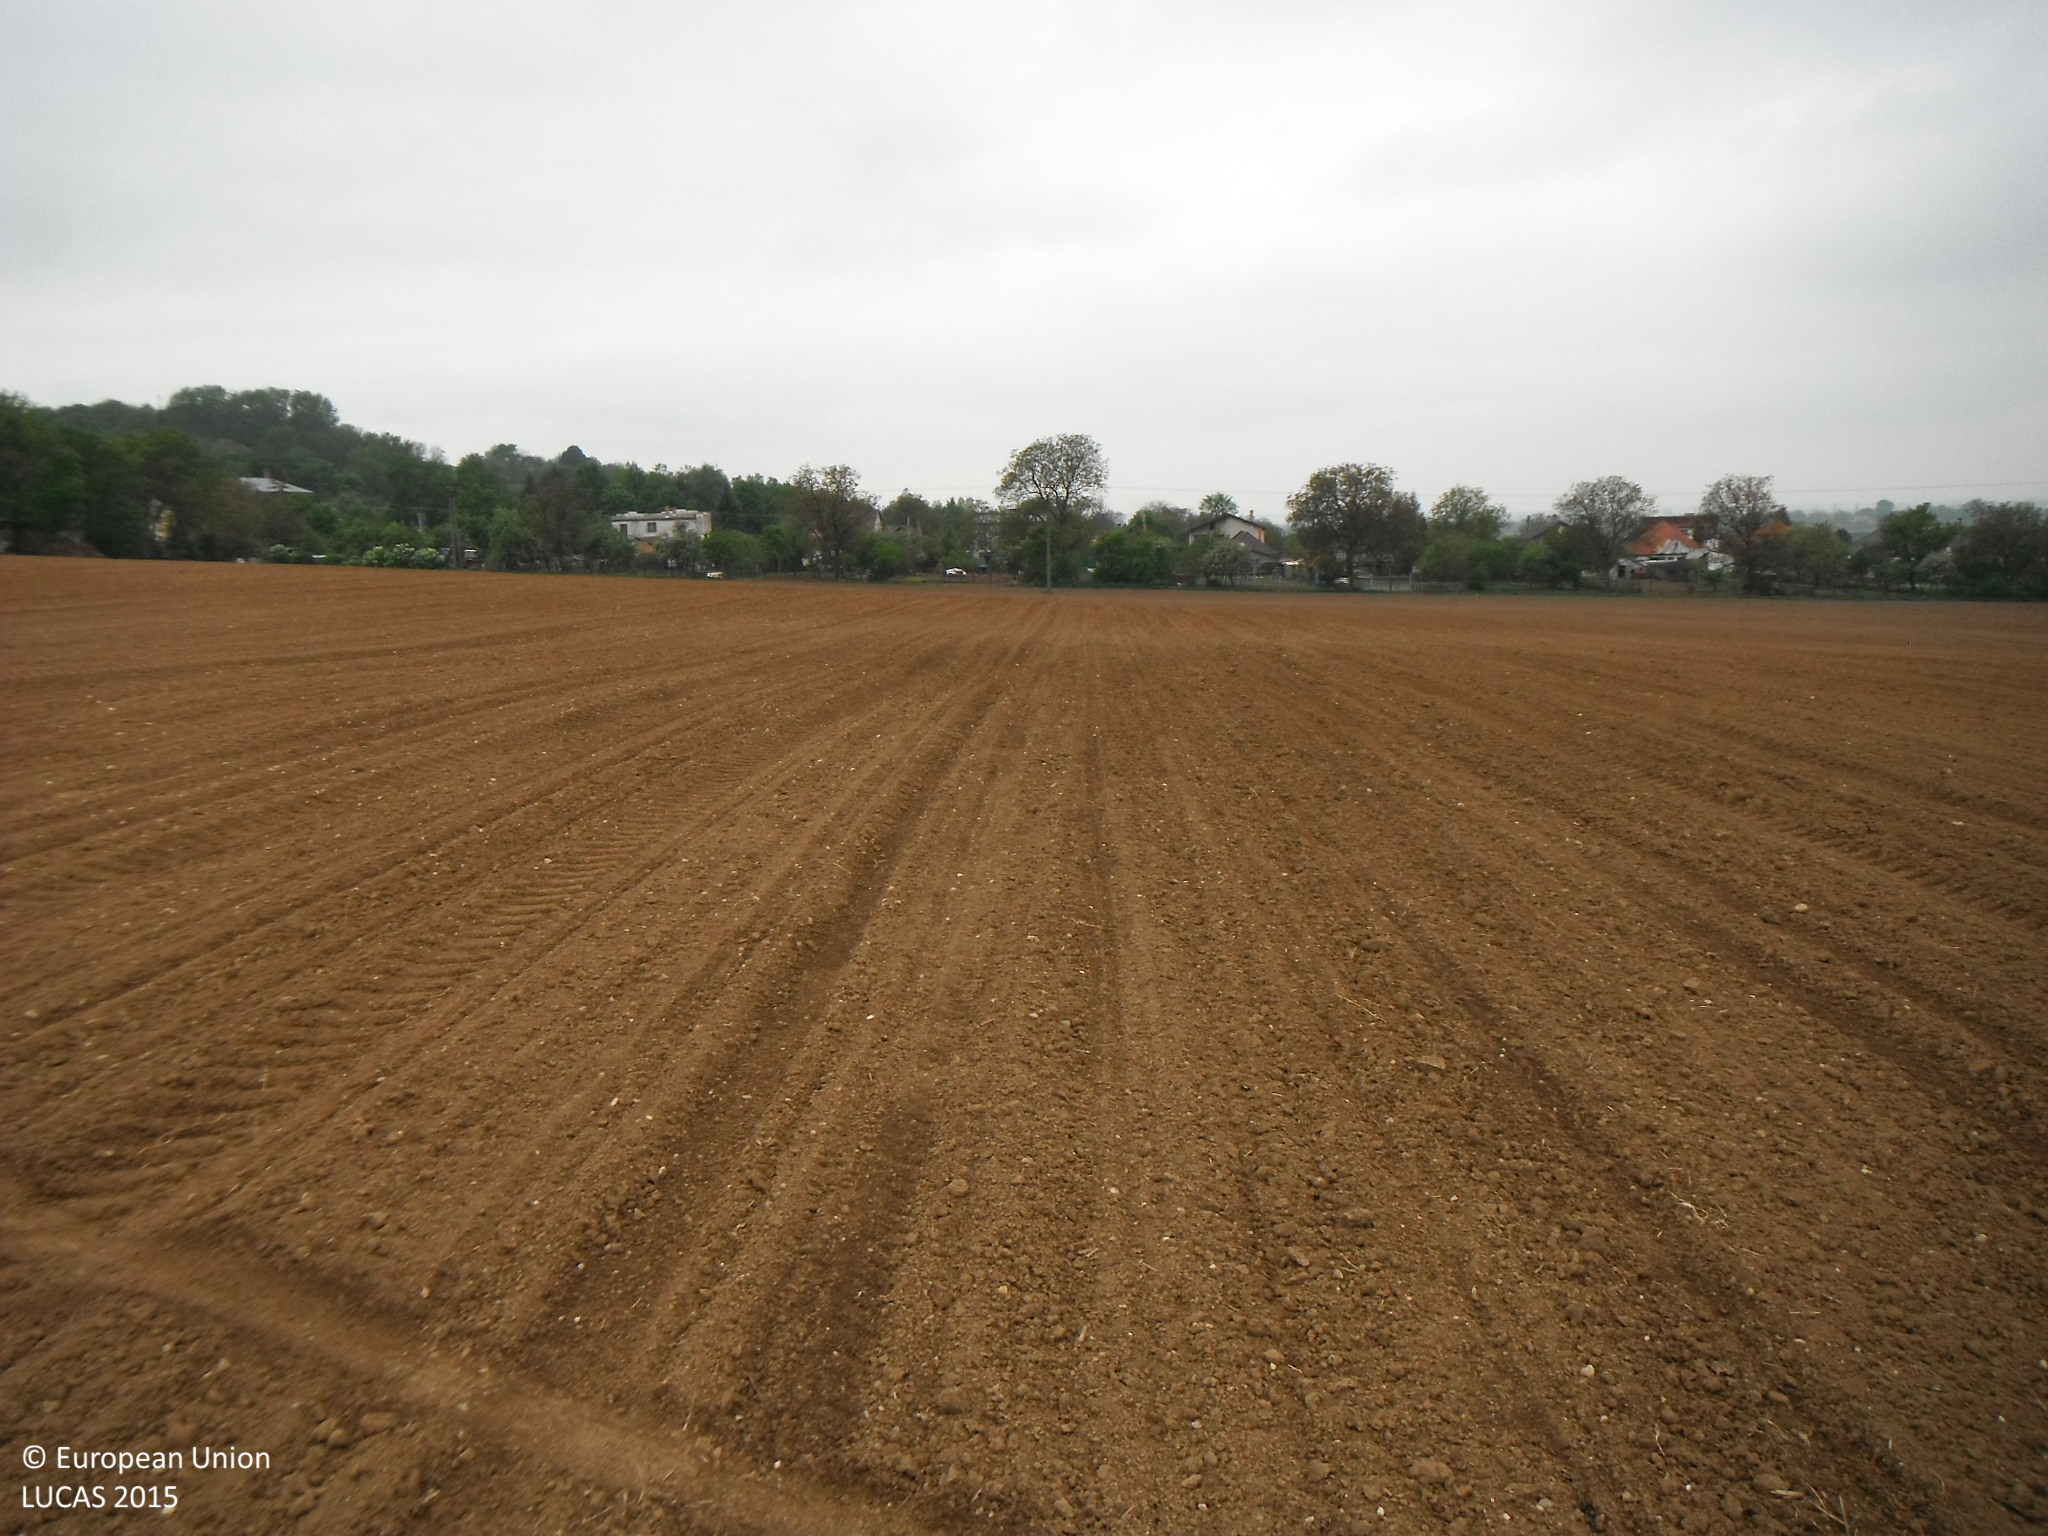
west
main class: Cropland
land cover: Maize
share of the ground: < 10 %
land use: Agriculture (excluding fallow land and kitchen gardens)
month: May
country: SK
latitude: 48.5295
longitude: 21.1329
